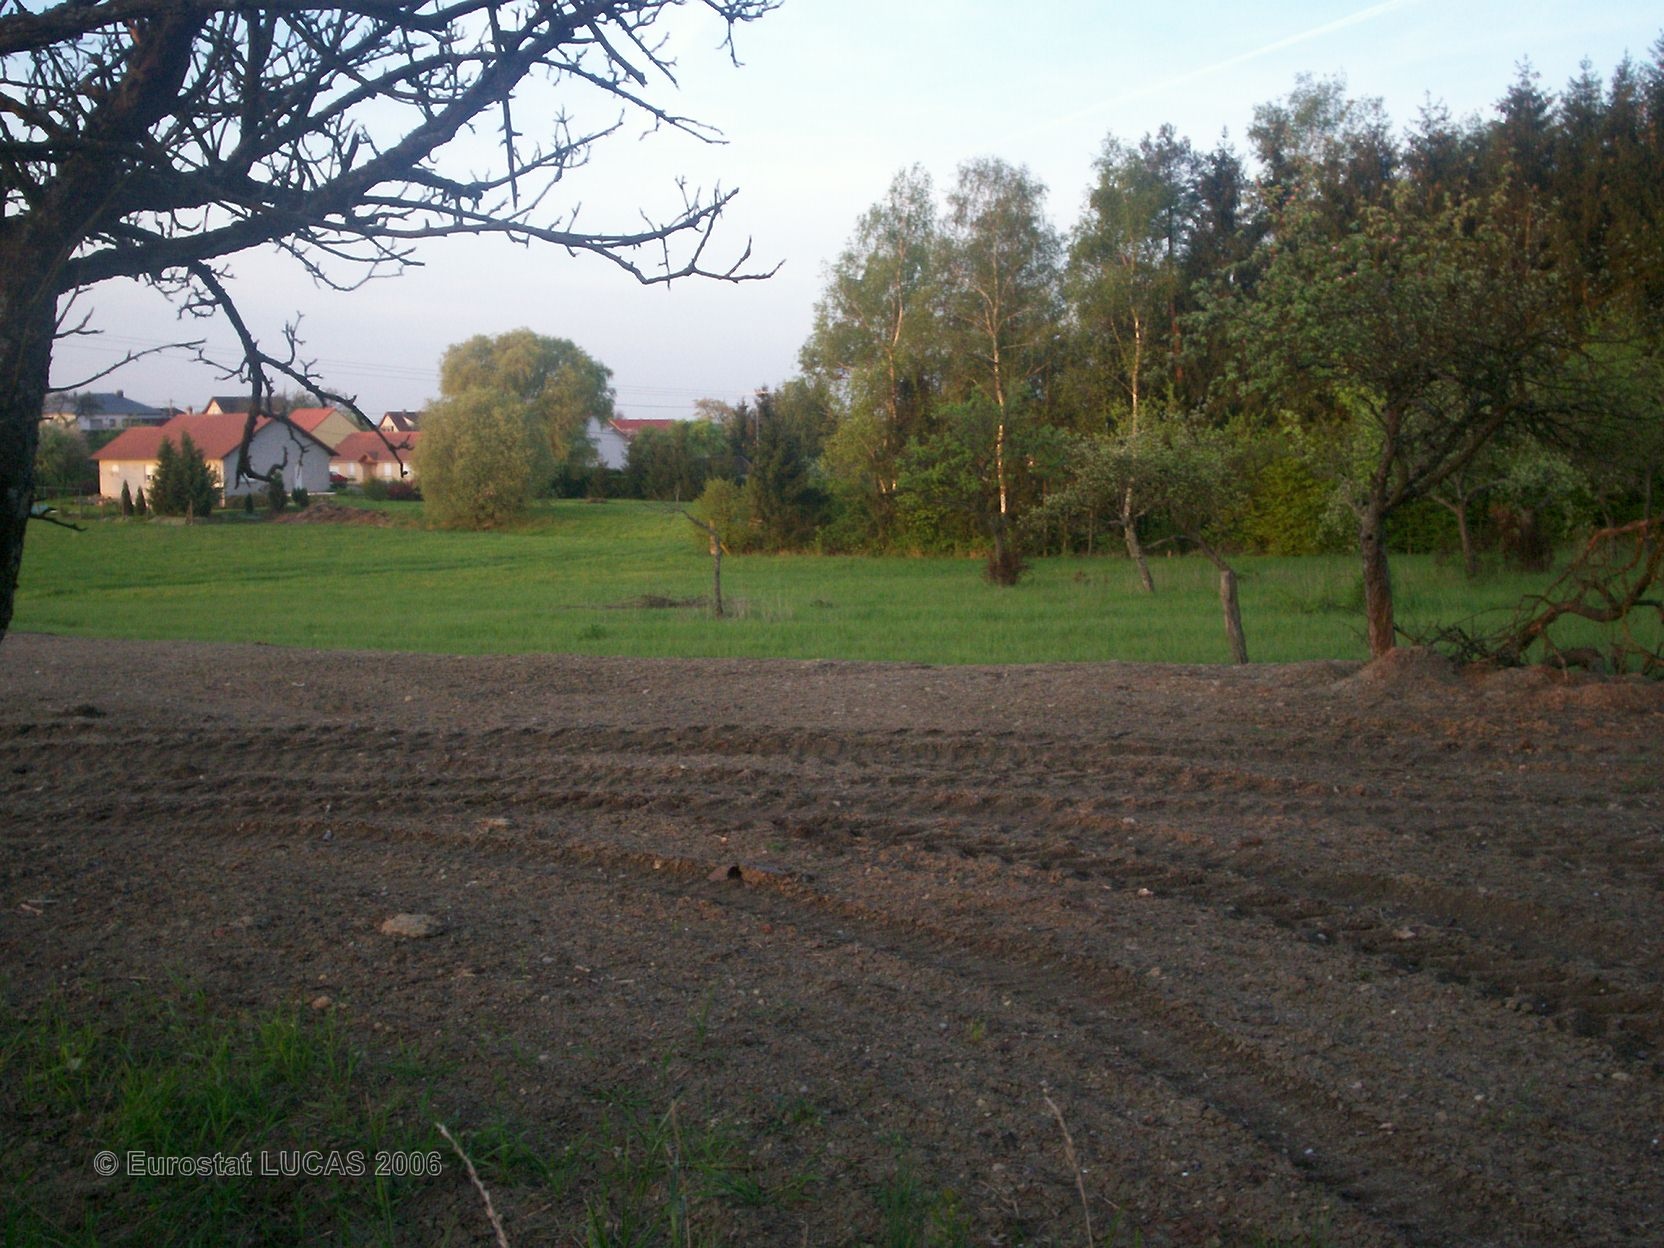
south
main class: Cropland
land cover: Apple fruit
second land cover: Grassland with sparse tree/shrub cover
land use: Agriculture (excluding fallow land and kitchen gardens)
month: May
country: FR
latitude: 49.0463
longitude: 6.9768
